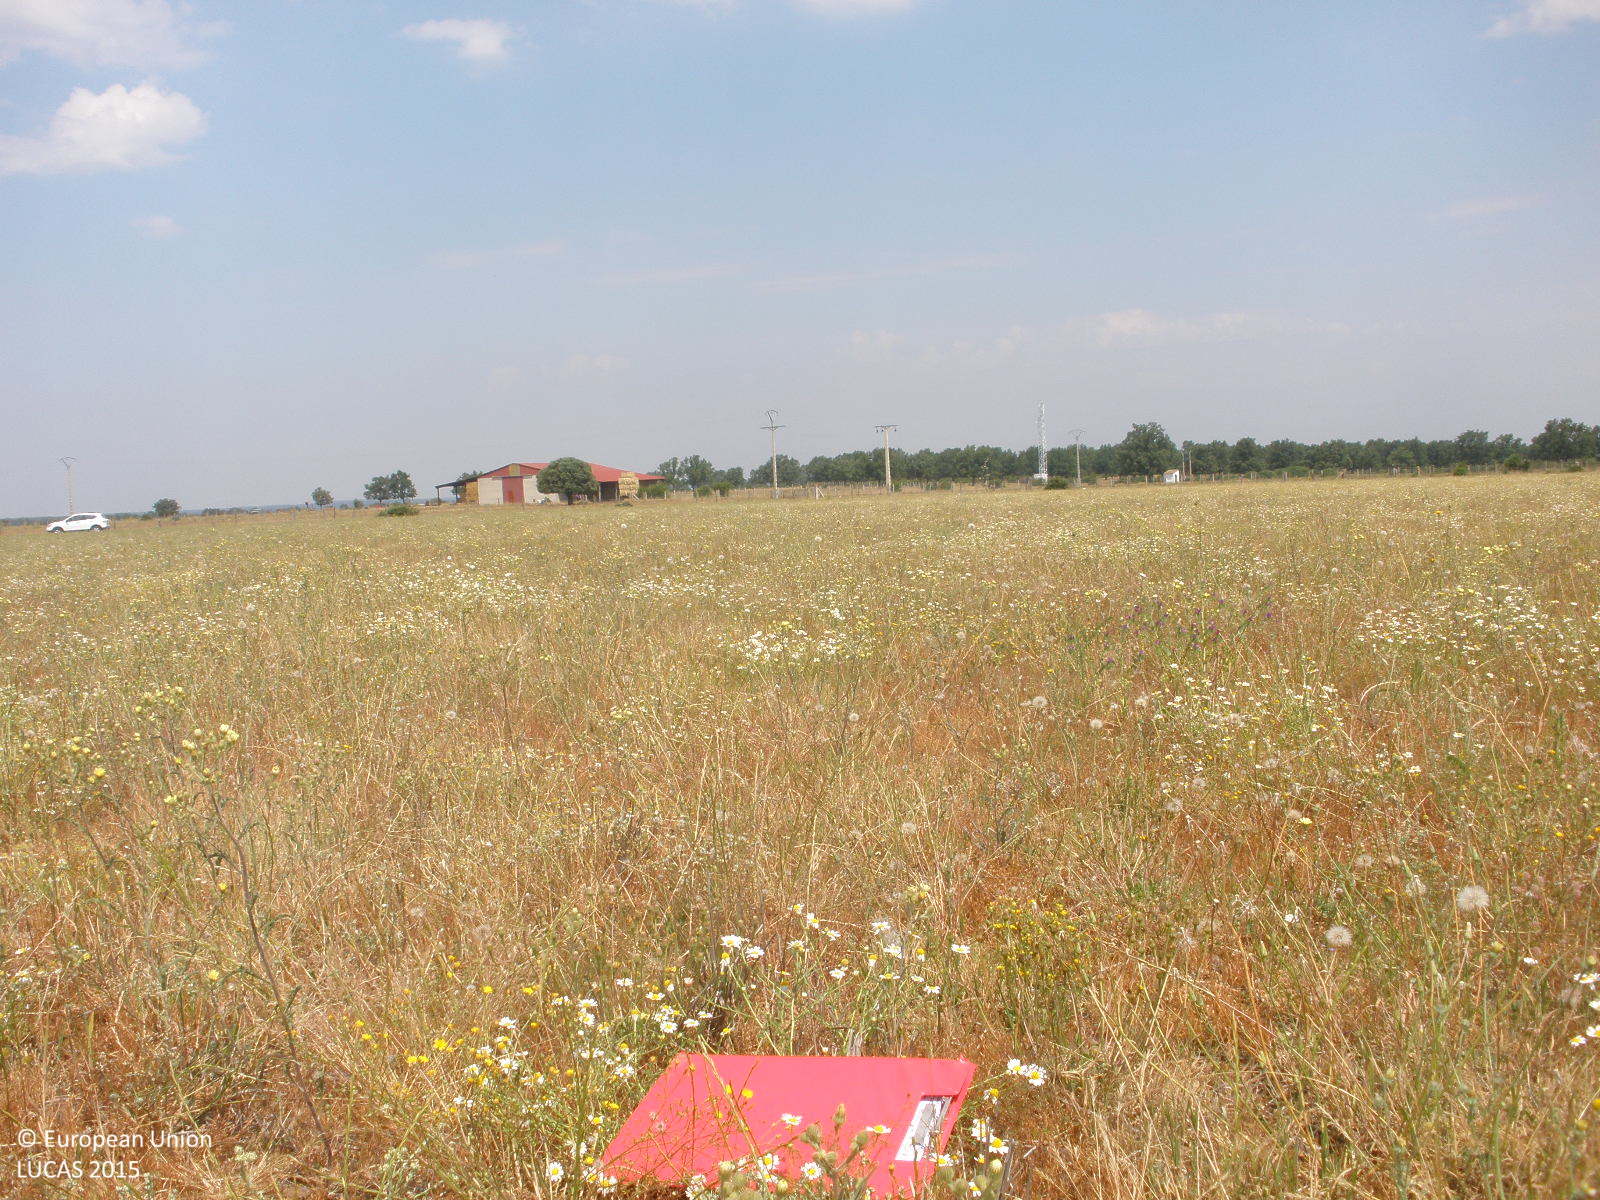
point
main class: Grassland
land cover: Grassland without tree/shrub cover
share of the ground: > 75 %
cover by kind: herbaceous plants 100 %
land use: Agriculture (excluding fallow land and kitchen gardens)
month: June
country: ES
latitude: 40.6392
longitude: -6.3205
